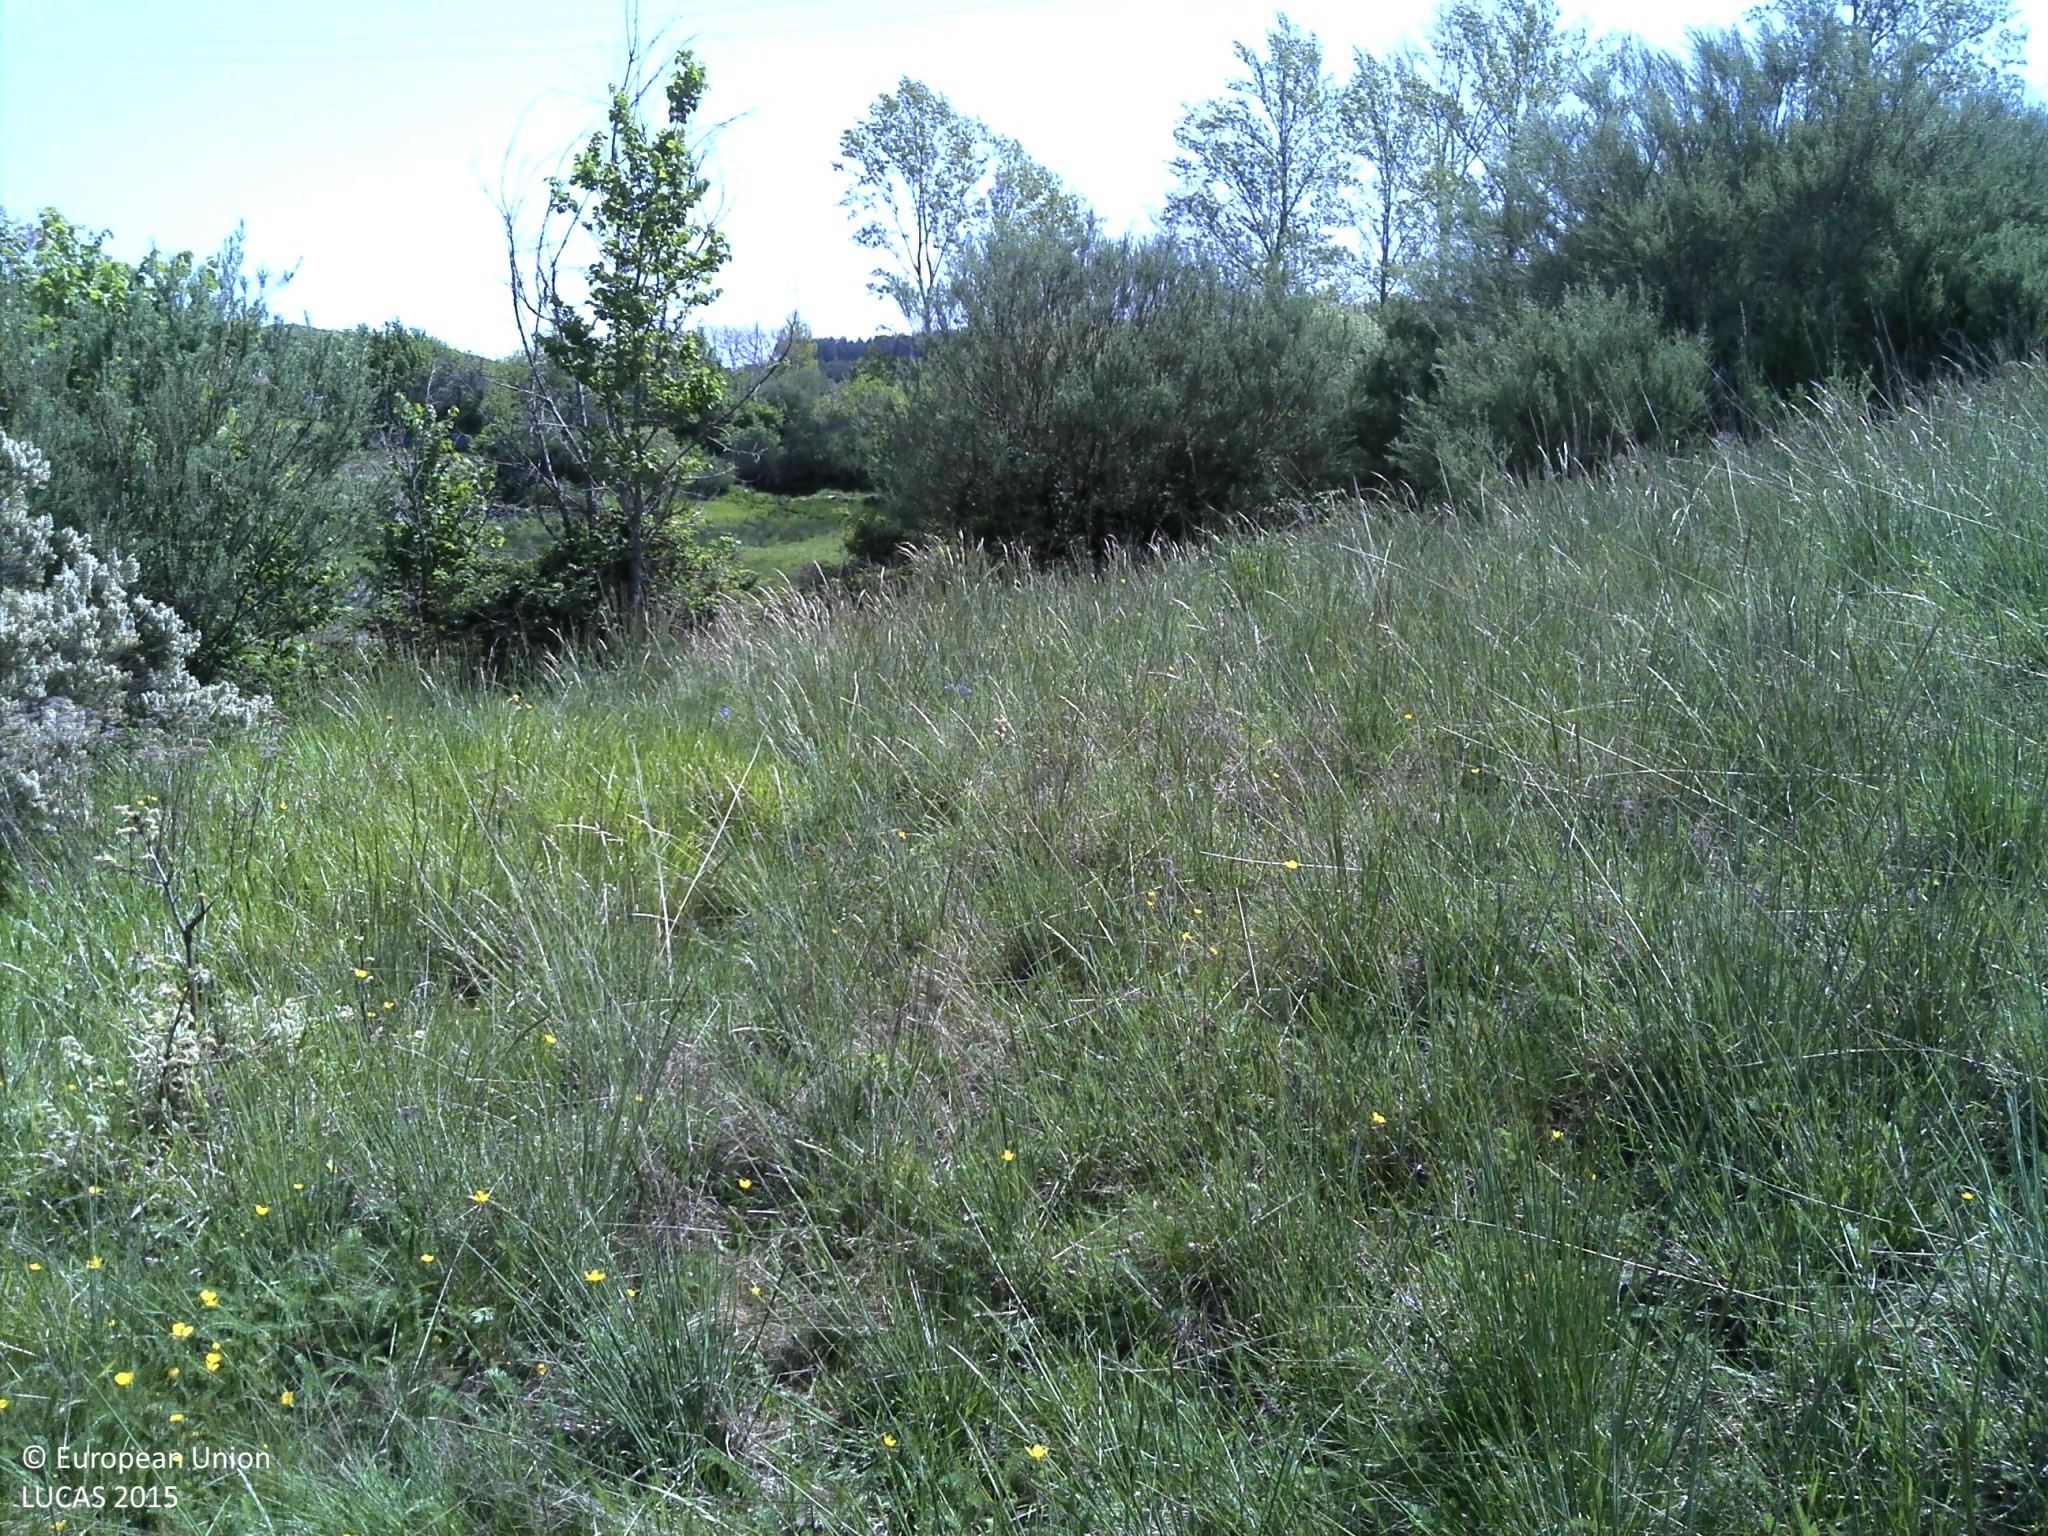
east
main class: Grassland
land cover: Grassland with sparse tree/shrub cover
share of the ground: > 75 %
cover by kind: herbaceous plants 95 %, broadleaved forest trees 5 %
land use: Agriculture (excluding fallow land and kitchen gardens)
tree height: > 5 m
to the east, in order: Grassland with sparse tree/shrub cover; Shruby margins; Dry stone walls; Shruby margins; Grassland without tree/shrub cover; Fences; Grassland without tree/shrub cover; Electric lines; Grassland without tree/shrub cover; Lines of trees; Grassland without tree/shrub cover; Dry stone walls; Grass margins; Dry stone walls; Lines of trees; Grassland without tree/shrub cover; Fences; Shrubland with sparse tree cover; Tracks; Dry stone walls; Single bushes/trees; Grassland without tree/shrub cover; Shrubland without tree cover; Shrubland with sparse tree cover; Shrubland without tree cover; Electric lines; Shrubland without tree cover
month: May
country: PT
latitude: 41.9203
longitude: -7.0140
